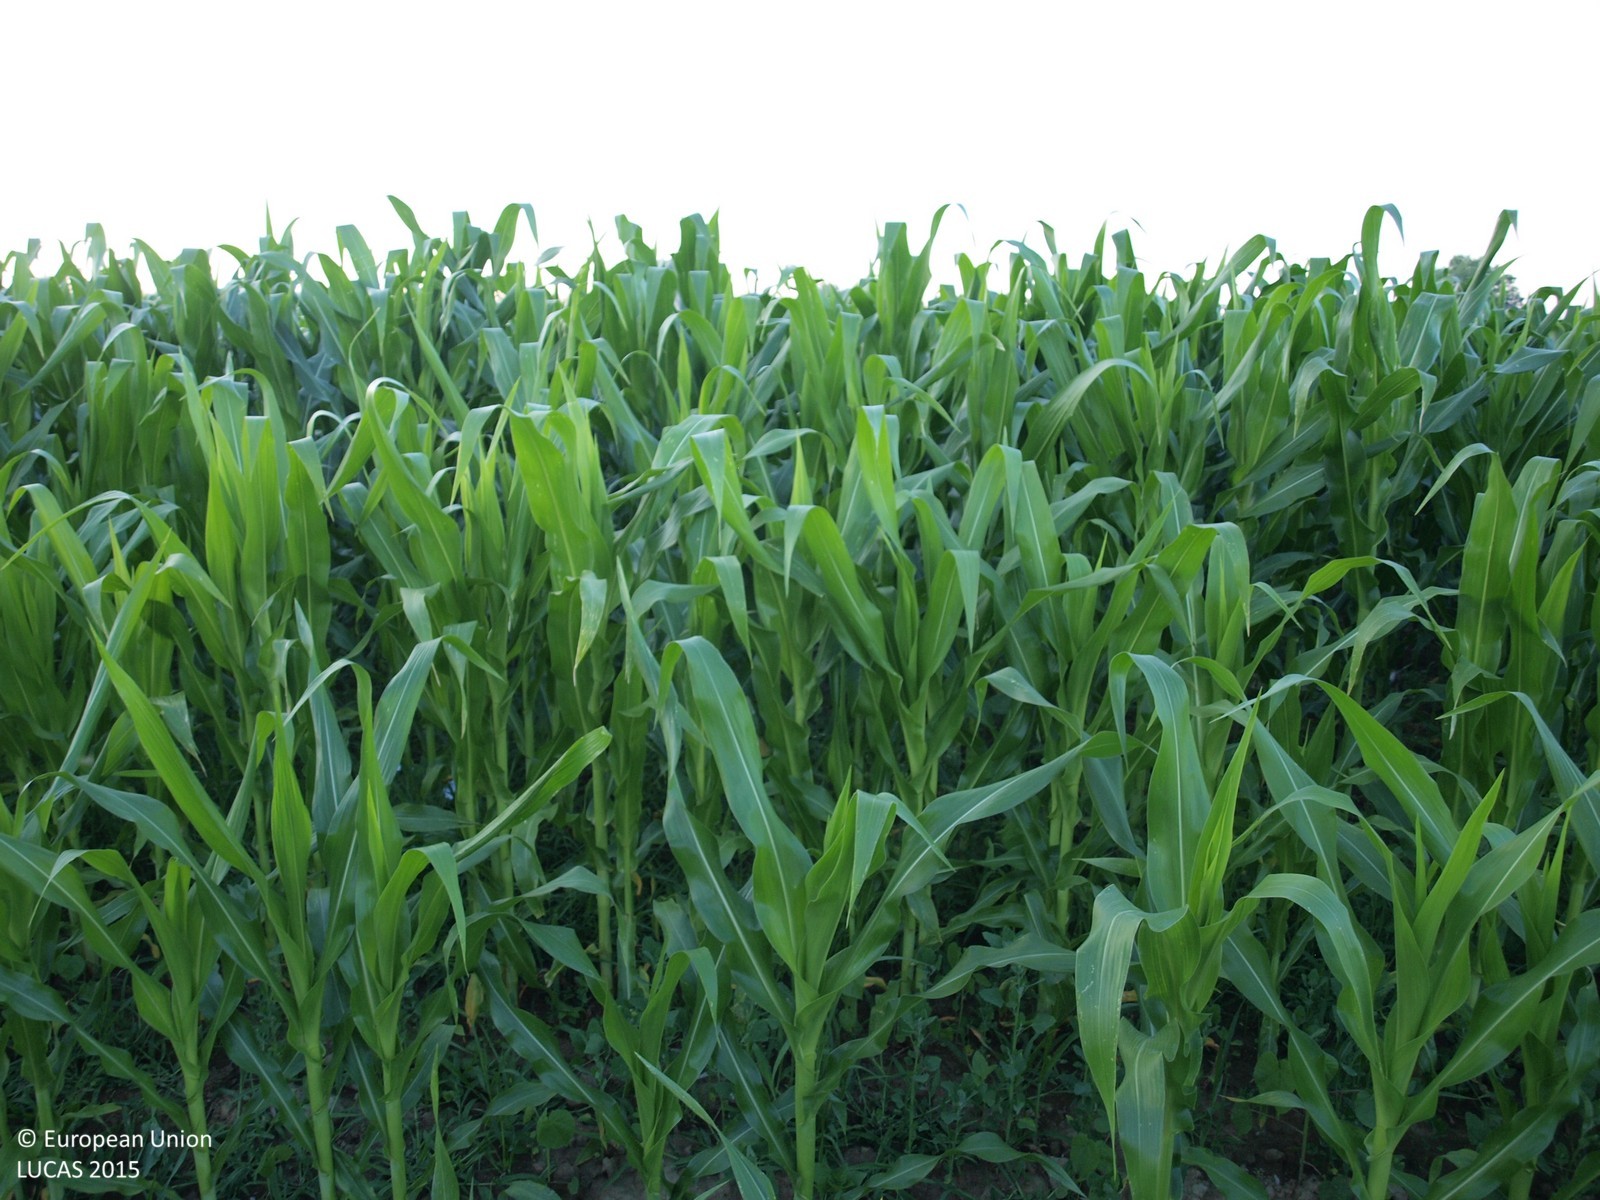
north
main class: Cropland
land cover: Maize
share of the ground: > 75 %
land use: Agriculture (excluding fallow land and kitchen gardens)
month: June
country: HR
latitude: 46.2750
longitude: 16.5800
